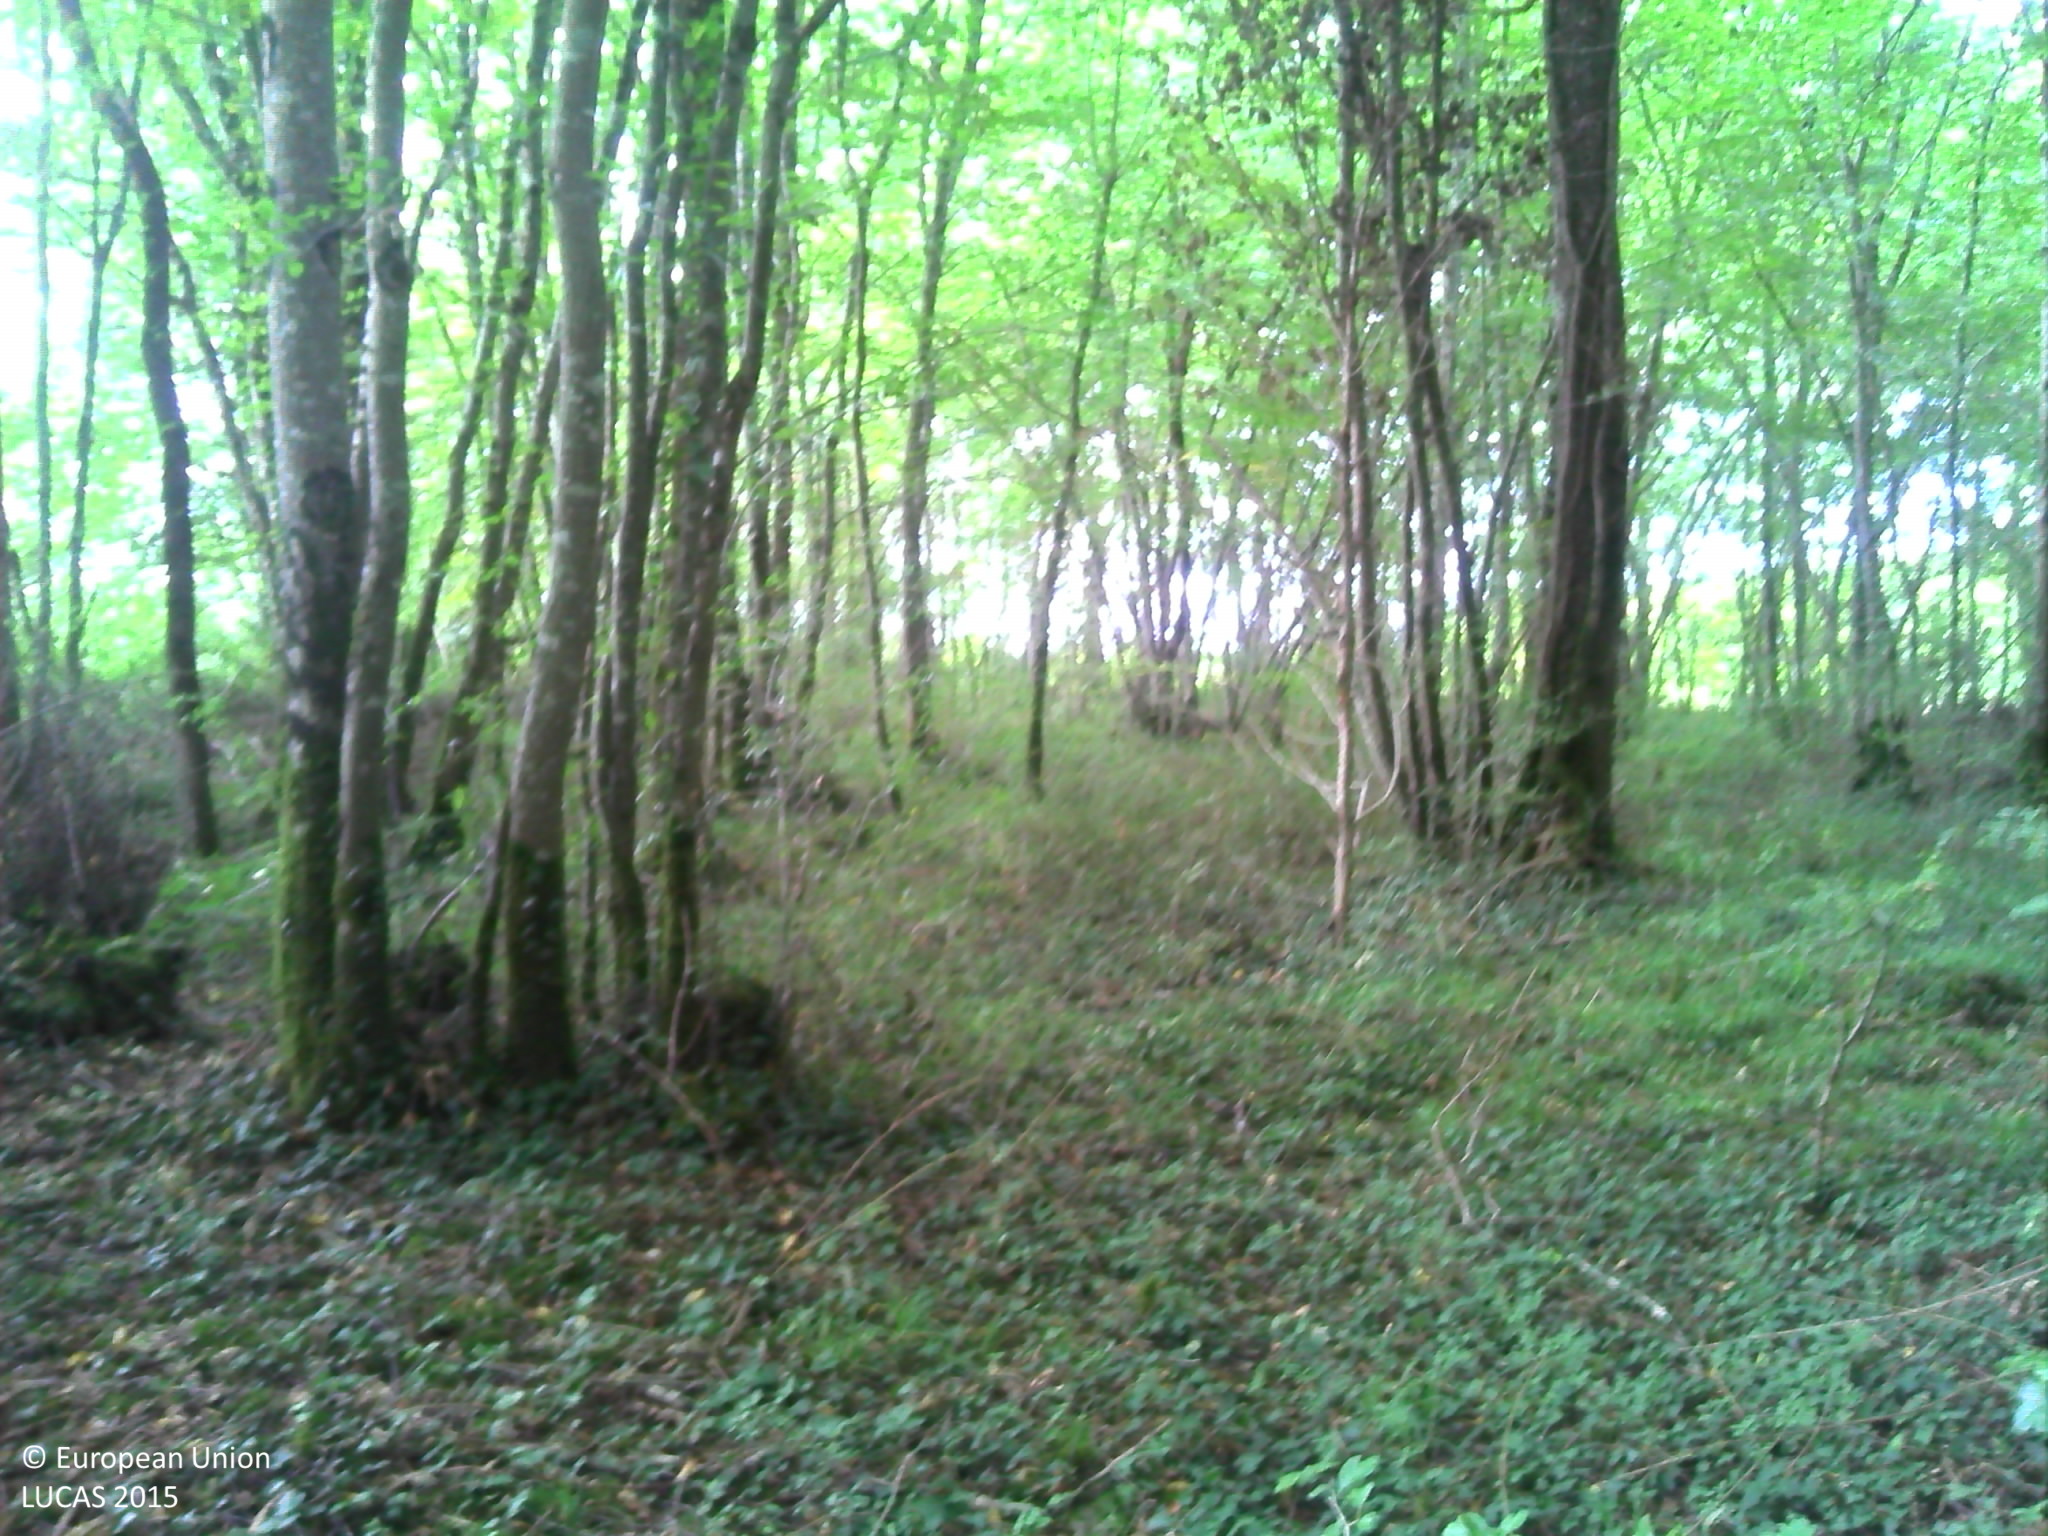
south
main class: Woodland
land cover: Broadleaved woodland
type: mesophytic deciduous forest
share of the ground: > 75 %
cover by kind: broadleaved forest trees 95 %, herbaceous plants 5 %
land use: Forestry
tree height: > 5 m
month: September
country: FR
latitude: 46.7781
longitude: 1.5677
